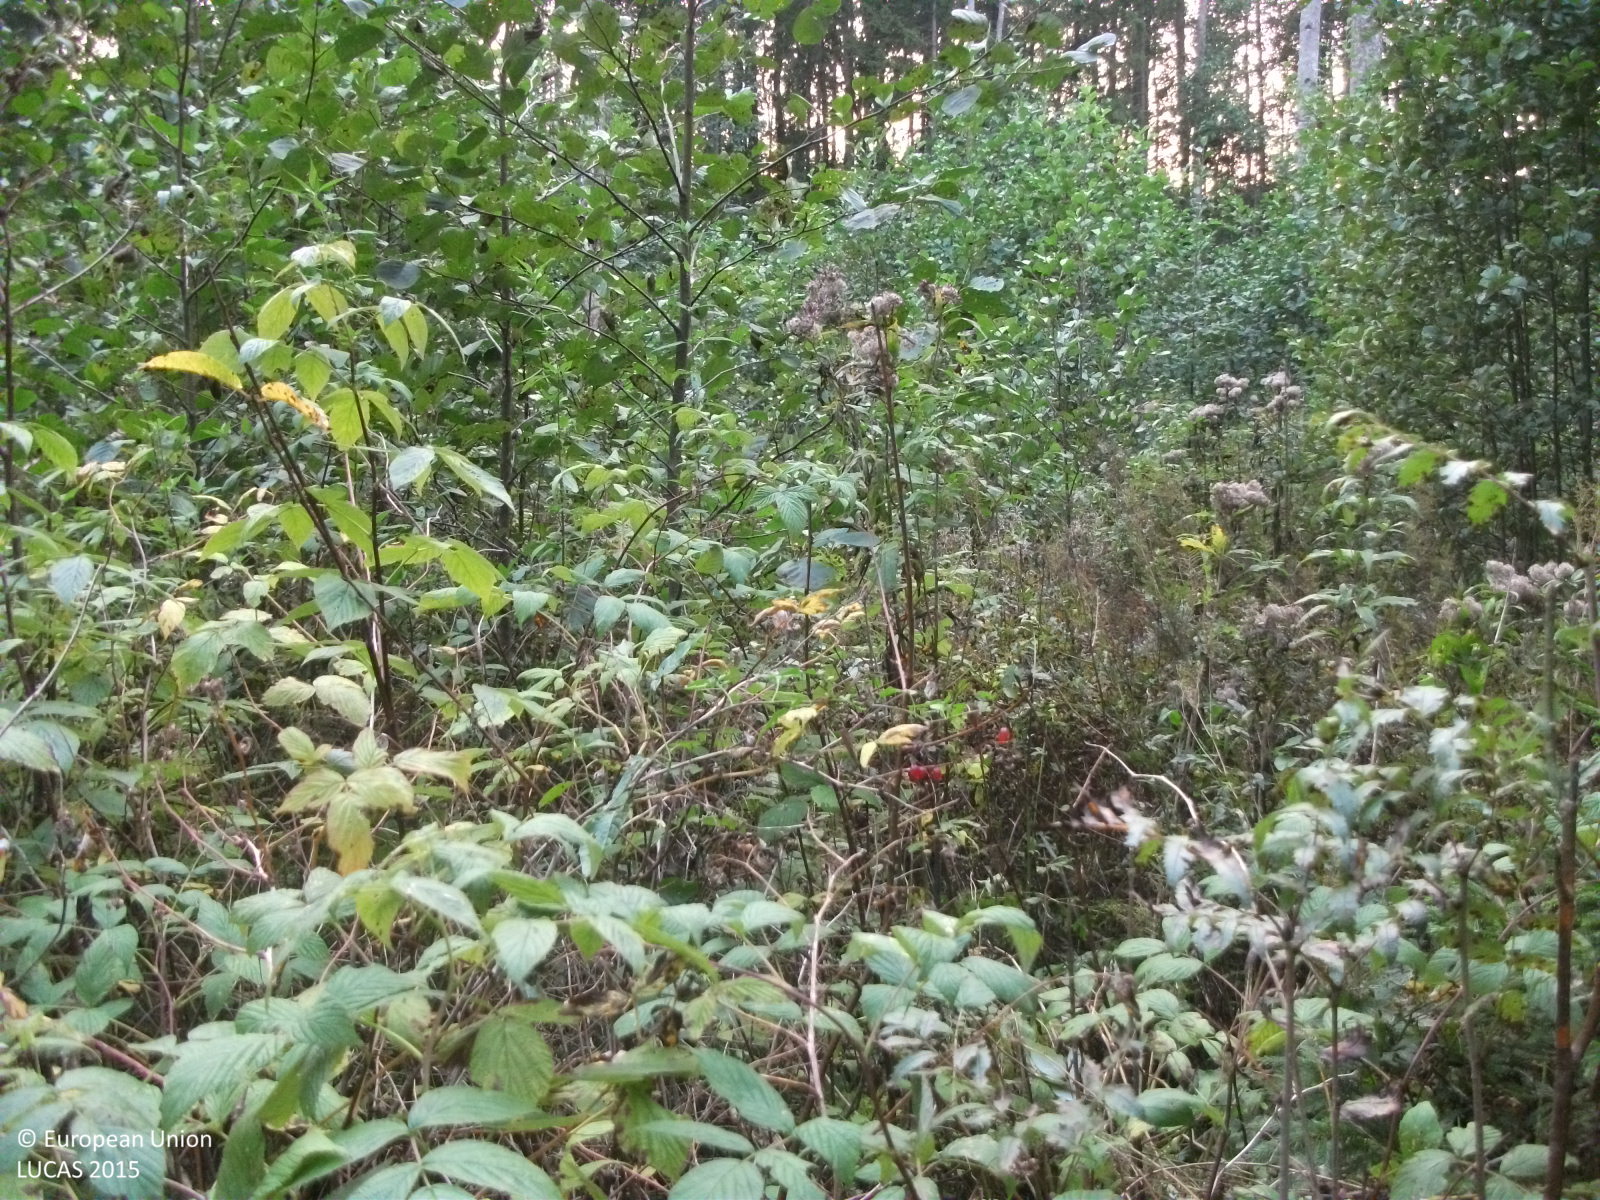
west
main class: Woodland
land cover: Broadleaved woodland
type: non-riverine alder, birch or aspen forest
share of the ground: 25 - 50 %
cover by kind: shrubs 50 %, broadleaved forest trees 40 %, herbaceous plants 10 %
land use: Forestry
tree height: < 5 m
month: September
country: LV
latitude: 57.8982
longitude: 24.5486
